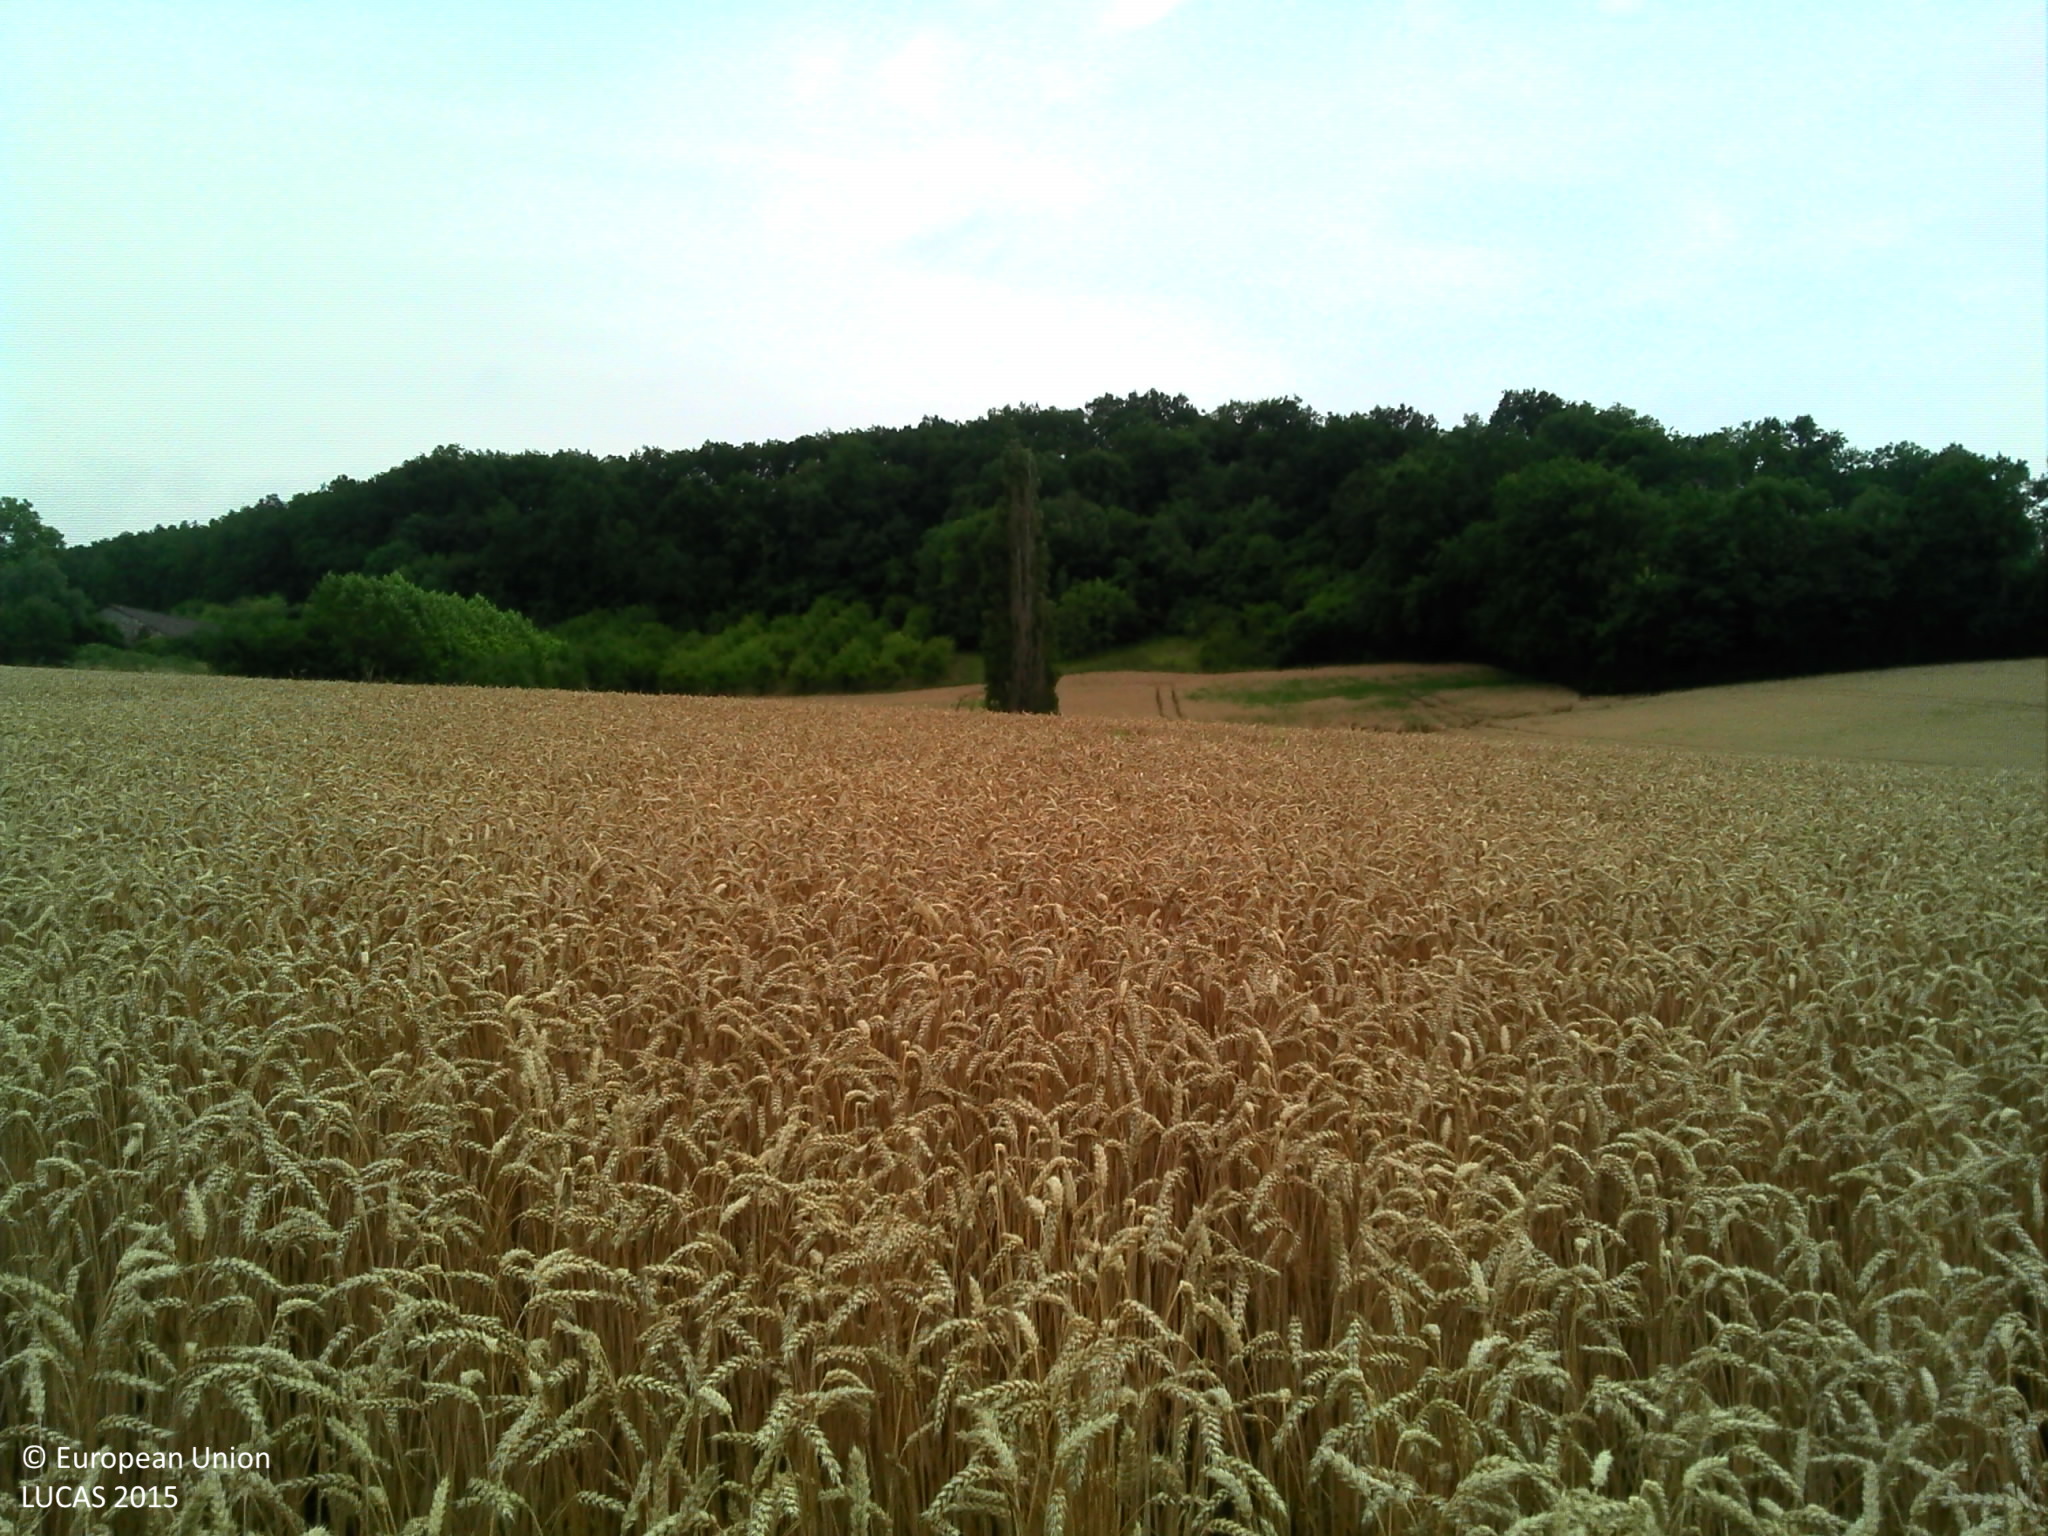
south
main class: Cropland
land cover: Common wheat
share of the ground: > 75 %
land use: Agriculture (excluding fallow land and kitchen gardens)
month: July
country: FR
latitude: 44.3426
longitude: 0.8261
